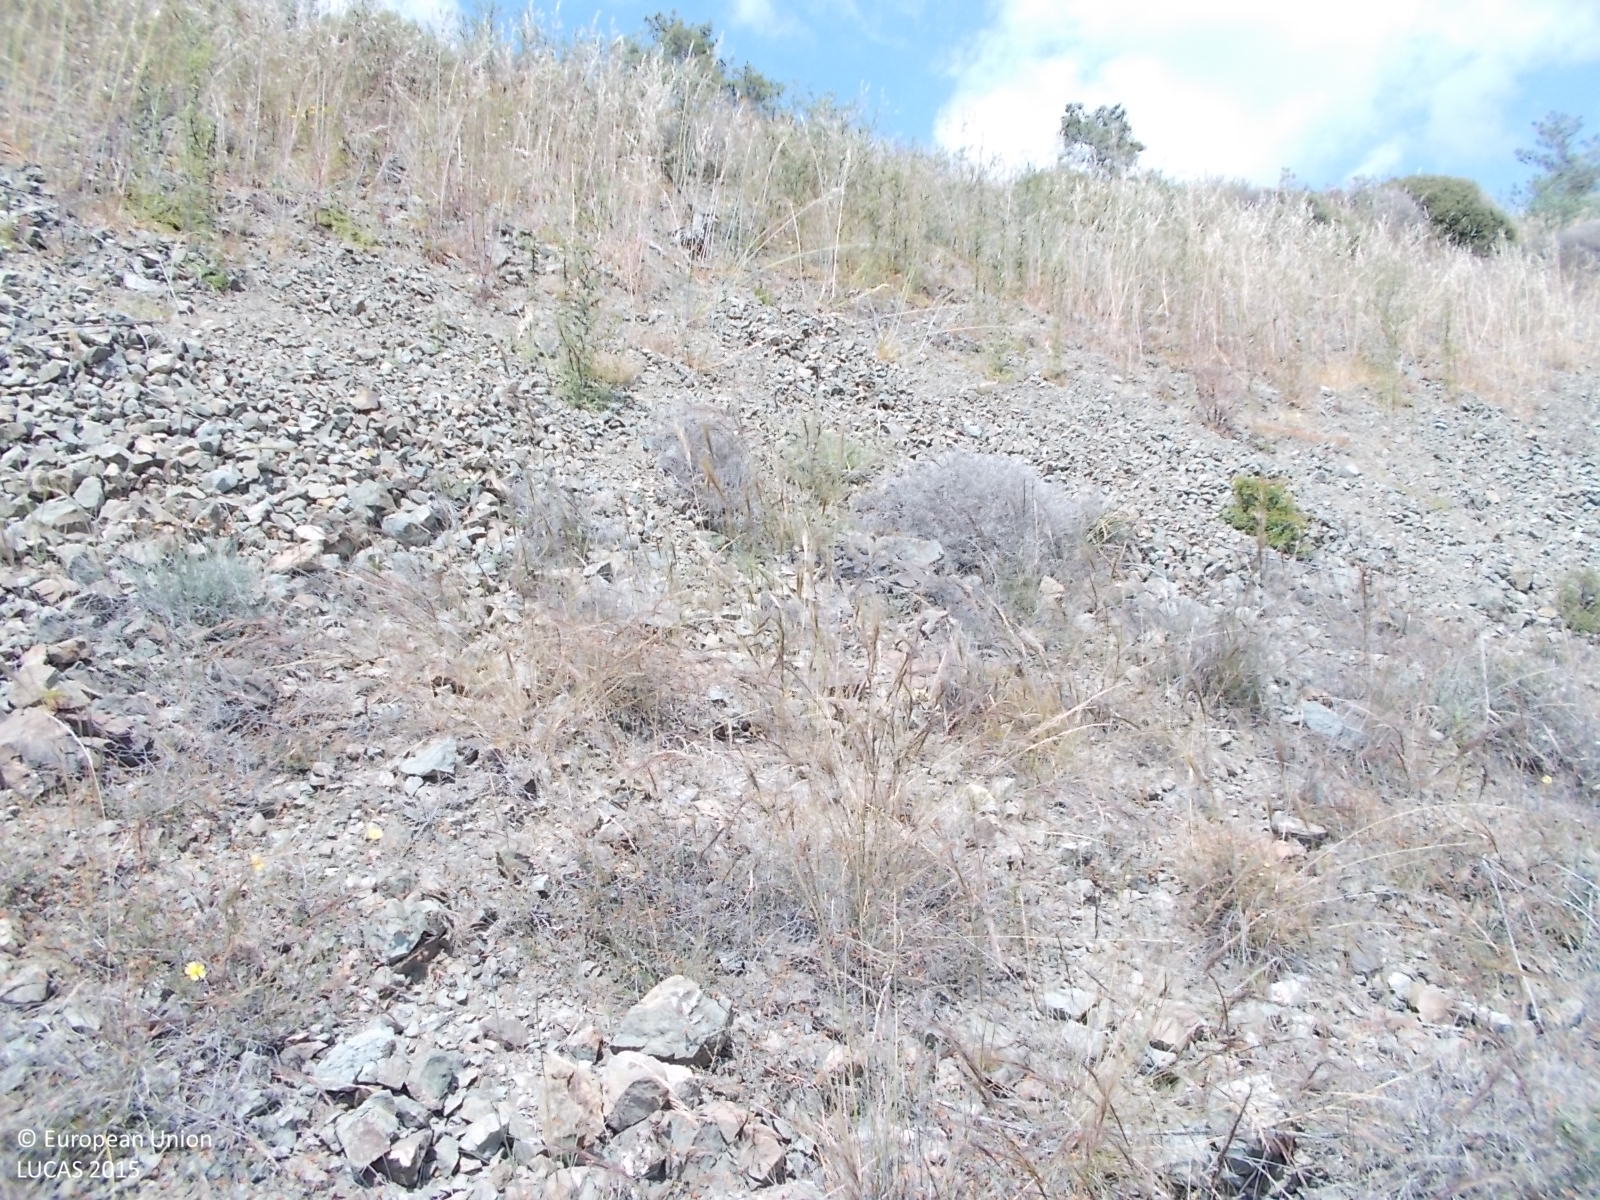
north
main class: Shrubland
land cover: Shrubland with sparse tree cover
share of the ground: 50 - 75 %
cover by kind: shrubs 60 %, unconsolidated bare surface 35 %, broadleaved forest trees 5 %
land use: Semi-natural and natural areas not in use
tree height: > 5 m
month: April
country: CY
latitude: 34.7620
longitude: 33.1246
